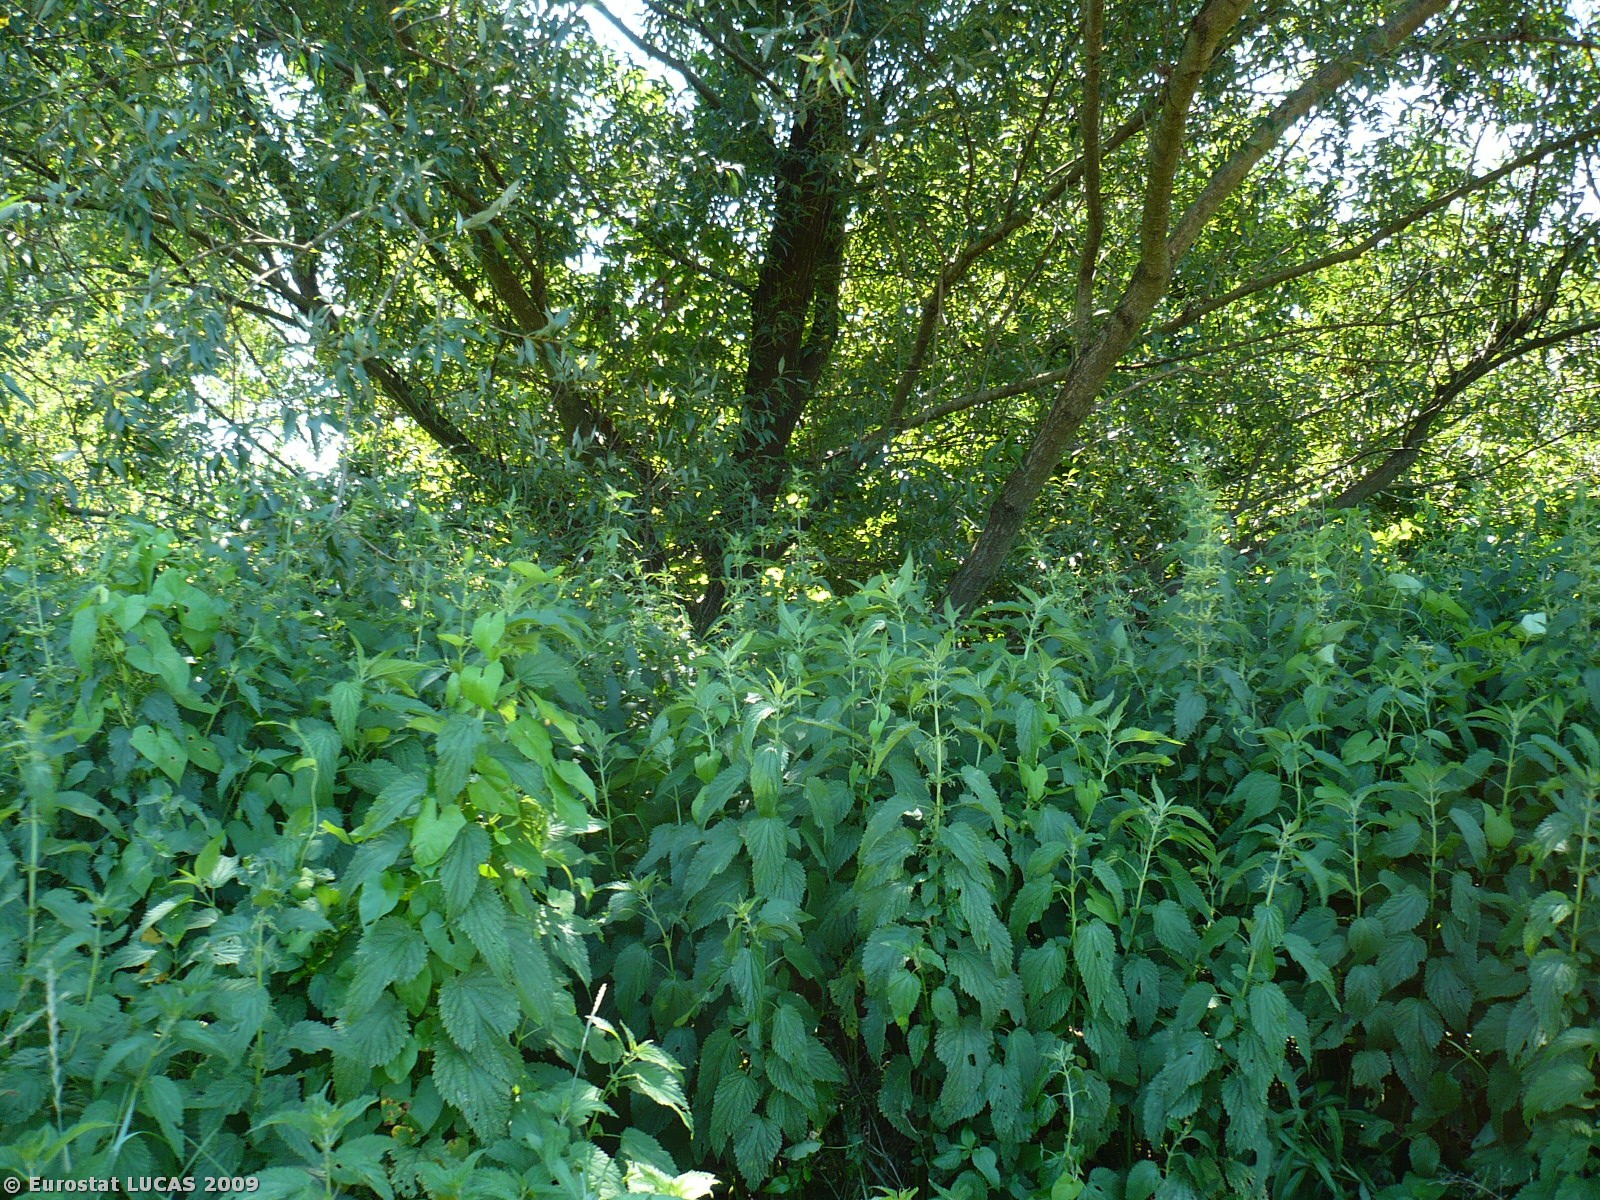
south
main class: Woodland
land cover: Broadleaved woodland
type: floodplain forest
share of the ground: > 75 %
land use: Unused
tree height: > 5 m
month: July
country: SI
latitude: 46.8109
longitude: 16.0684
